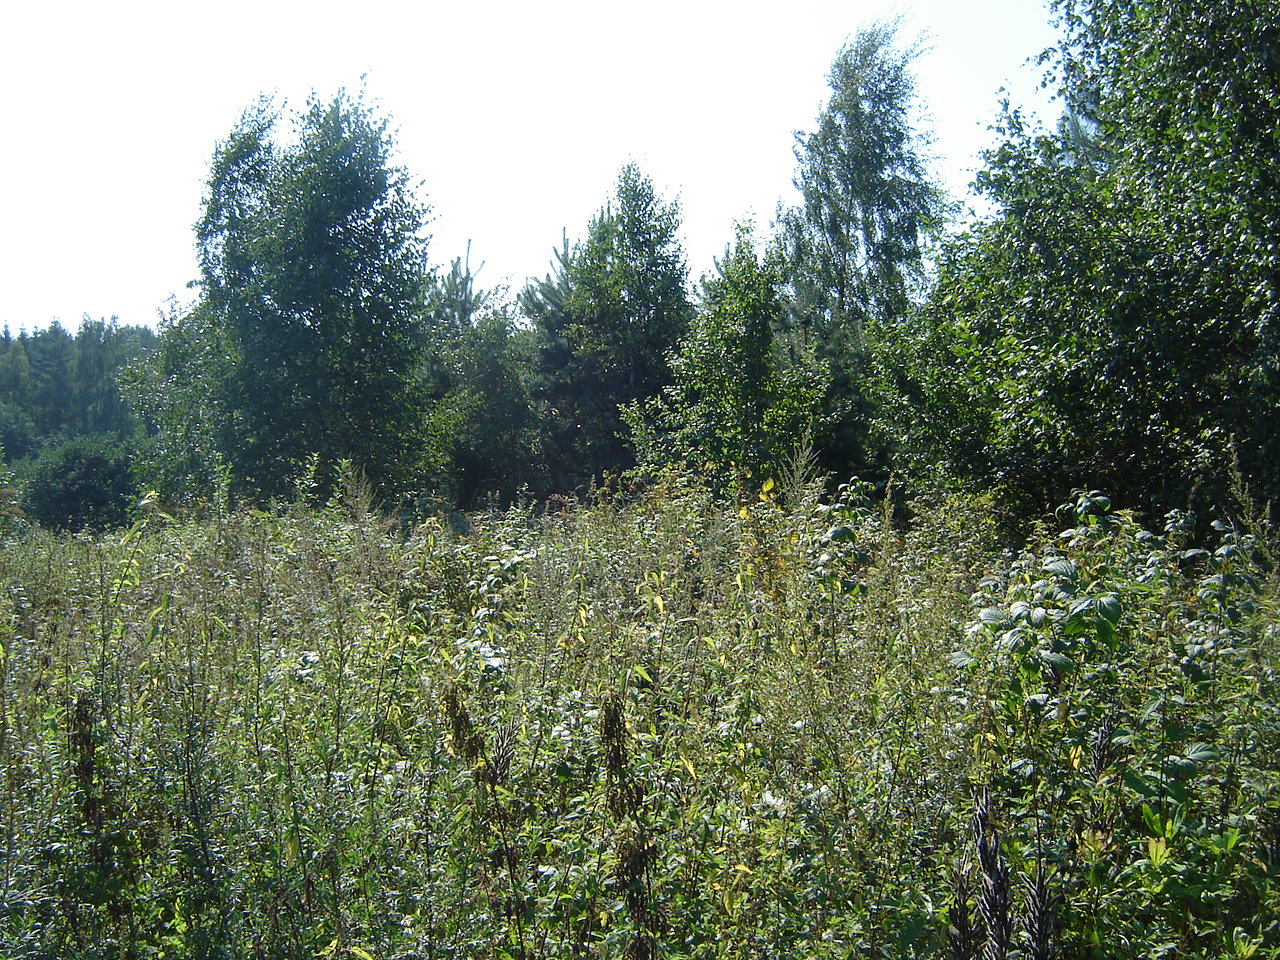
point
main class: Woodland
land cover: Pine dominated mixed woodland
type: hemiboreal forest and nemoral coniferous forest and mixed broadleaved-coniferous forest
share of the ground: > 75 %
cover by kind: coniferous forest trees 45 %, broadleaved forest trees 45 %, herbaceous plants 10 %
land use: Forestry
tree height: > 5 m
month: August
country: LT
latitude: 54.8858
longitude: 24.7775
